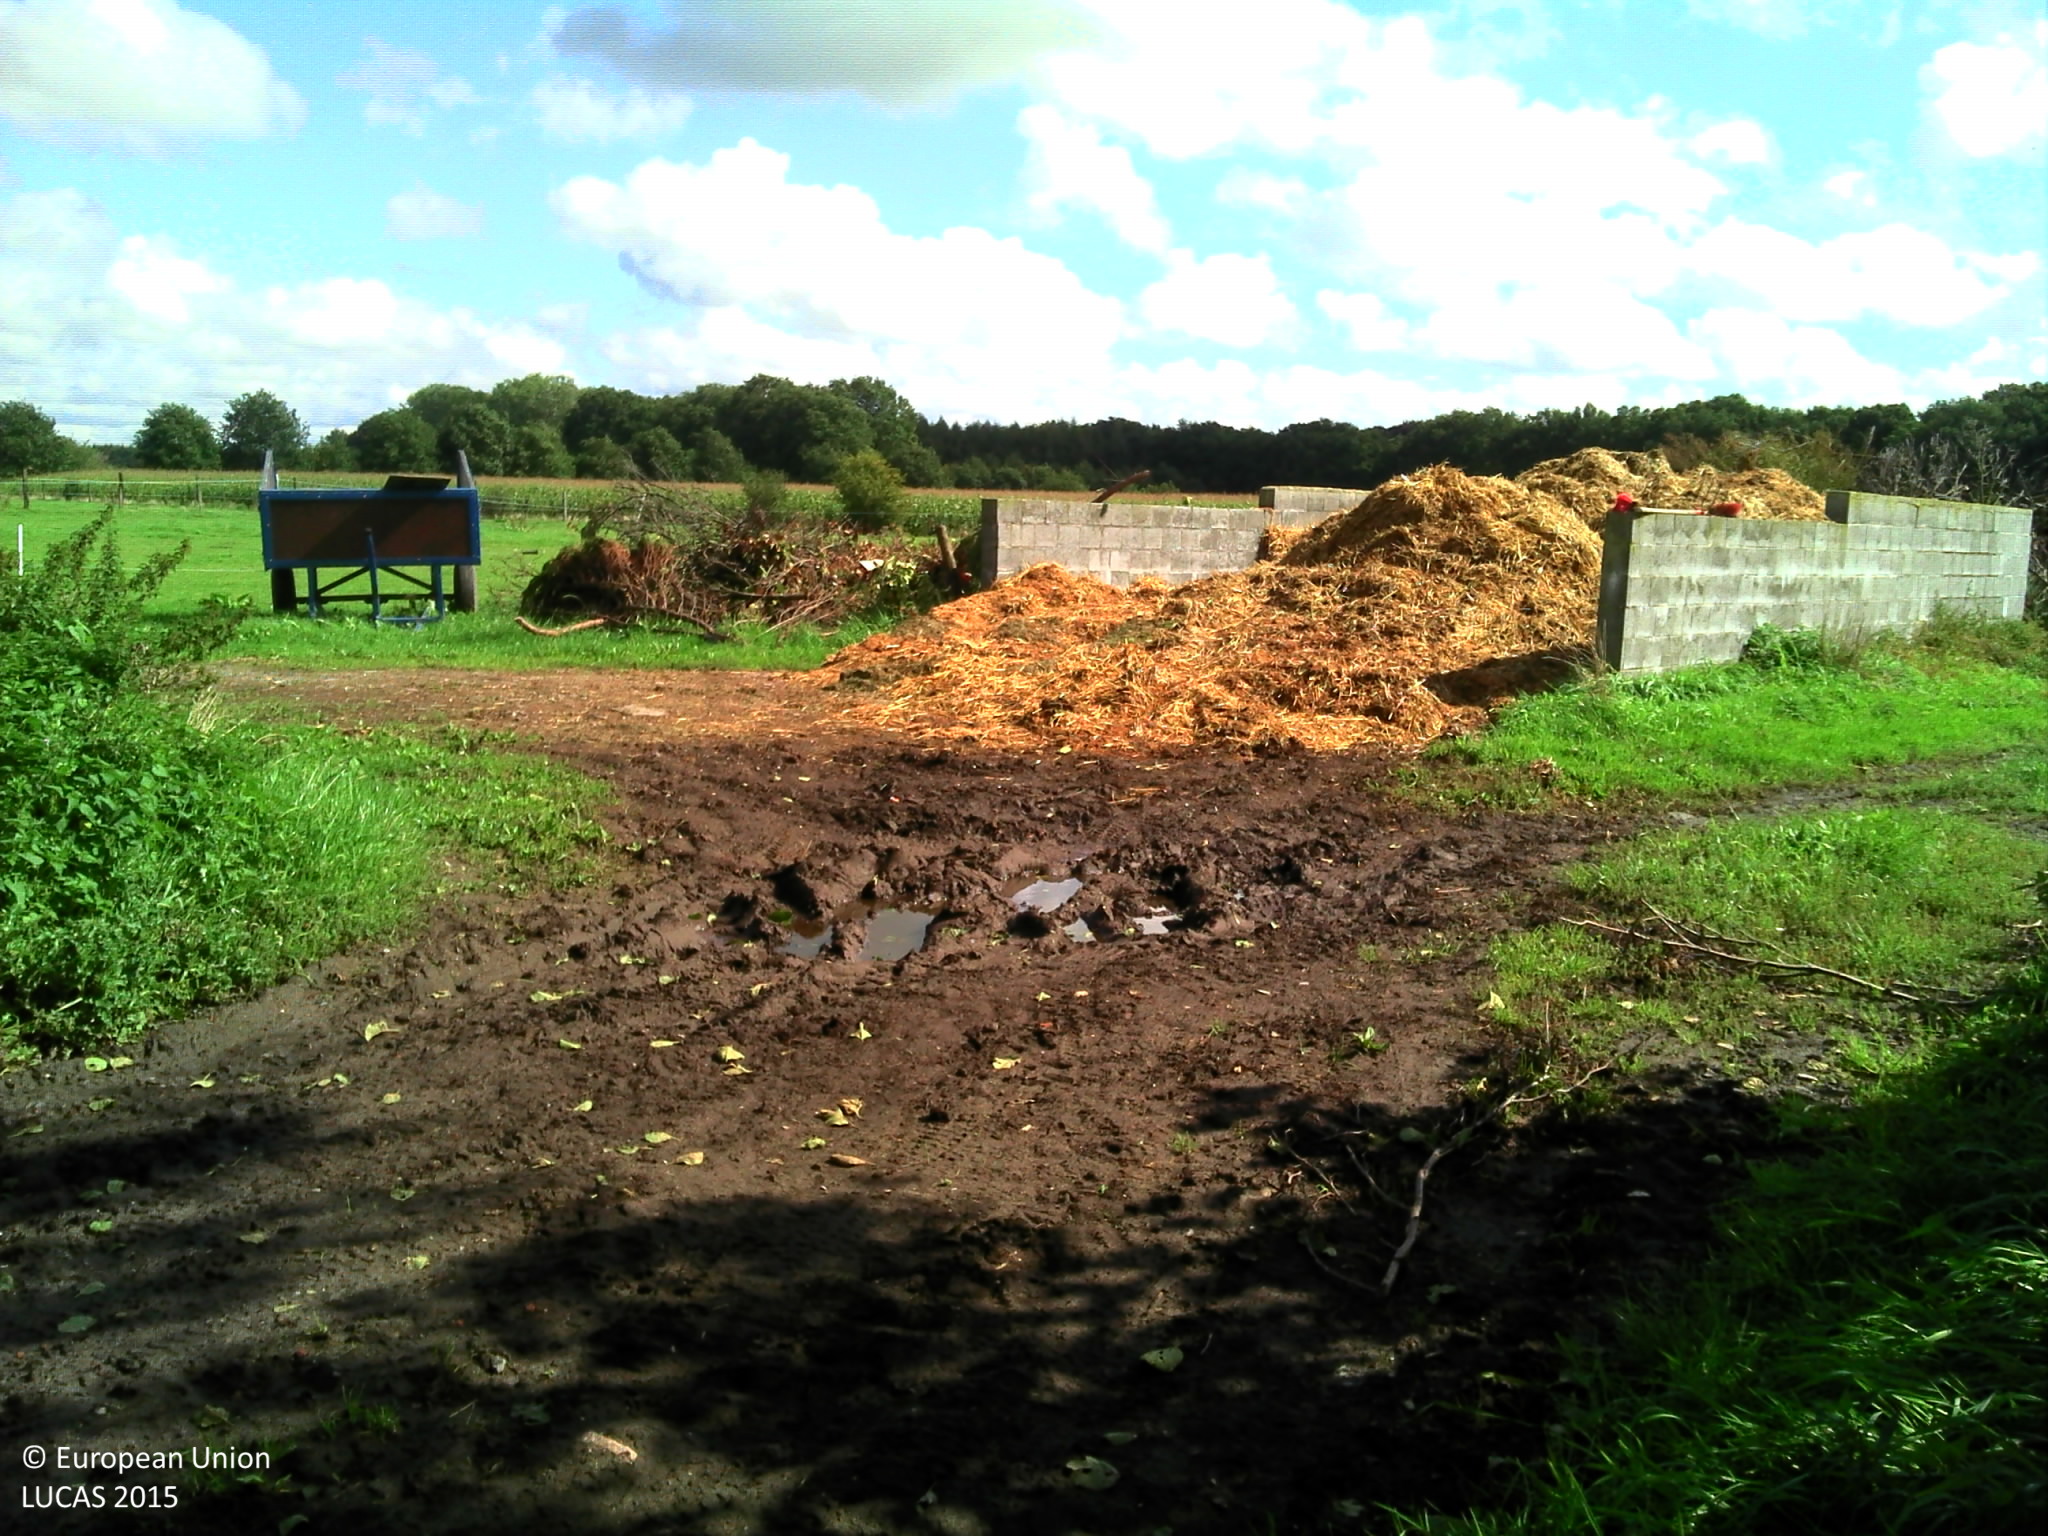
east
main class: Cropland
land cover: Maize
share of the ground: > 75 %
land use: Agriculture (excluding fallow land and kitchen gardens)
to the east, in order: Maize; Grass margins; Ditches and canals; Grass margins; Tracks; Grass margins; Fences; Grassland without tree/shrub cover; Fences; Grass margins; Ditches and canals; Grass margins; Maize
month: September
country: BE
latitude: 51.3775
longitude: 4.7237
